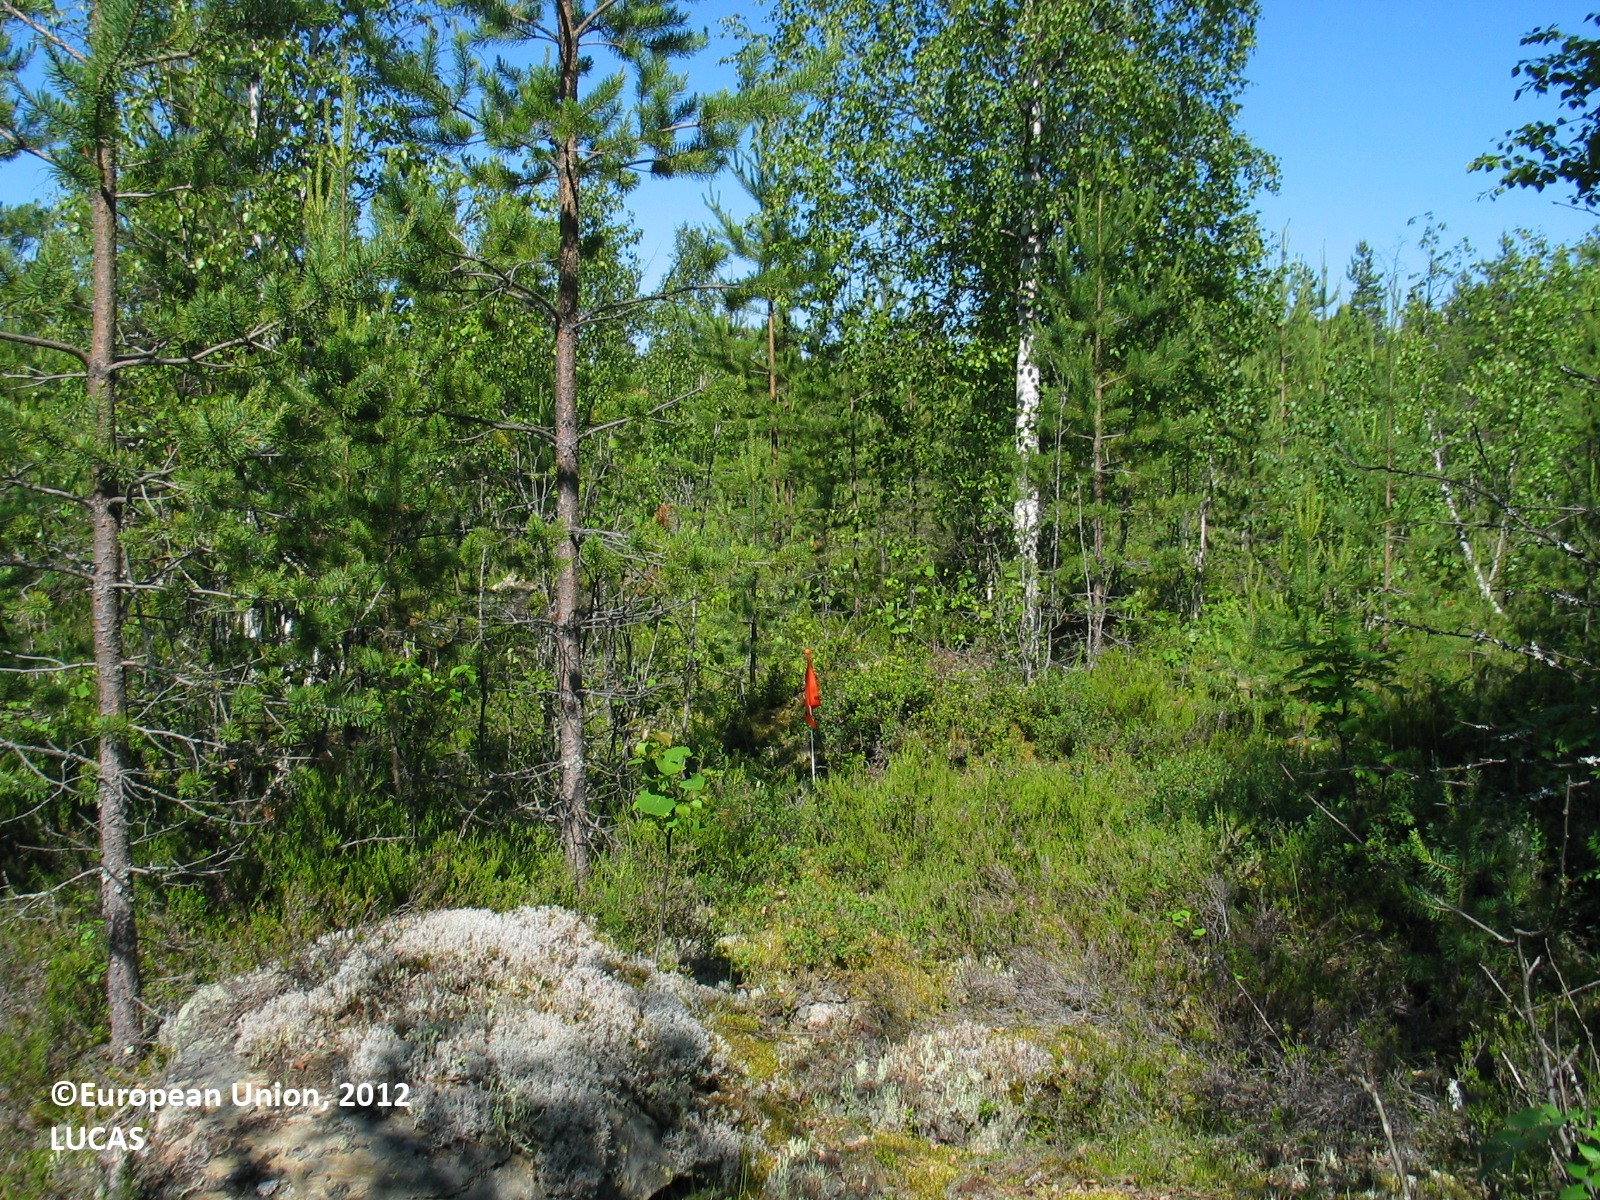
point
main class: Woodland
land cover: Other mixed woodland
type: boreal forest
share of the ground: 25 - 50 %
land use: Forestry
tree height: > 5 m
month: July
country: FI
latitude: 64.4813
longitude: 26.4019
